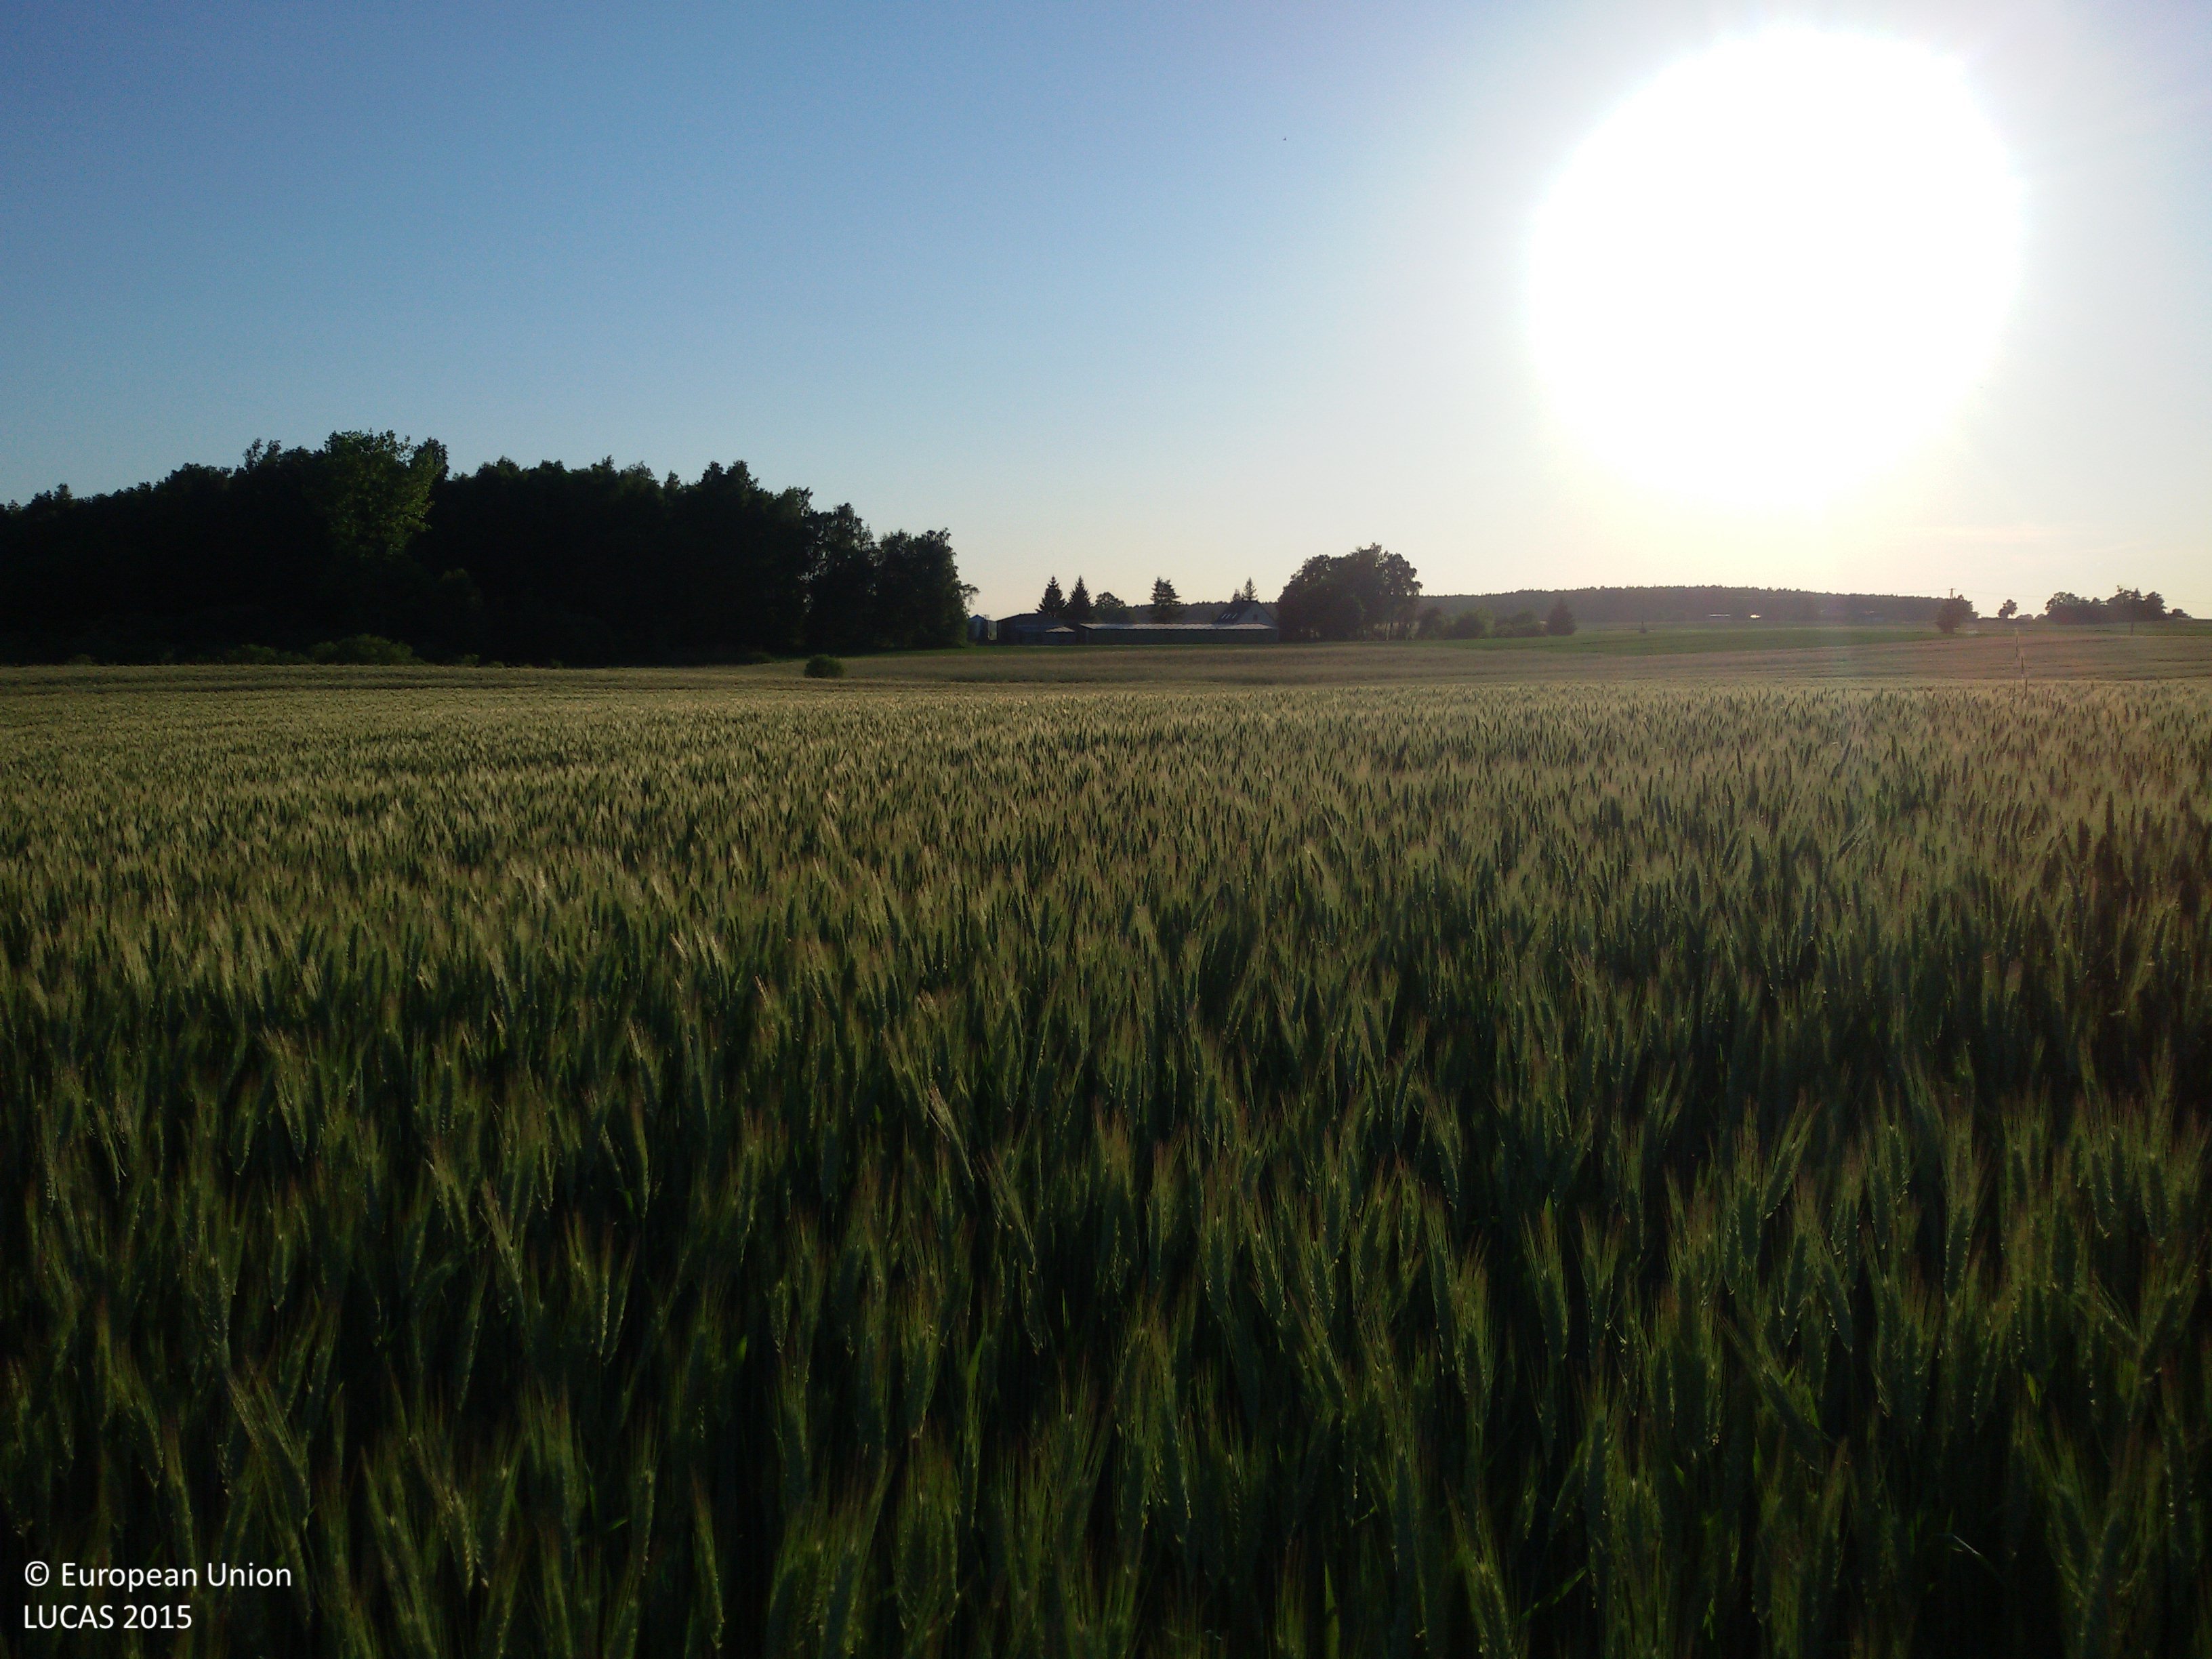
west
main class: Cropland
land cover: Triticale
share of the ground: > 75 %
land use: Agriculture (excluding fallow land and kitchen gardens)
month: June
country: PL
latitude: 53.2316
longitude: 17.0656
